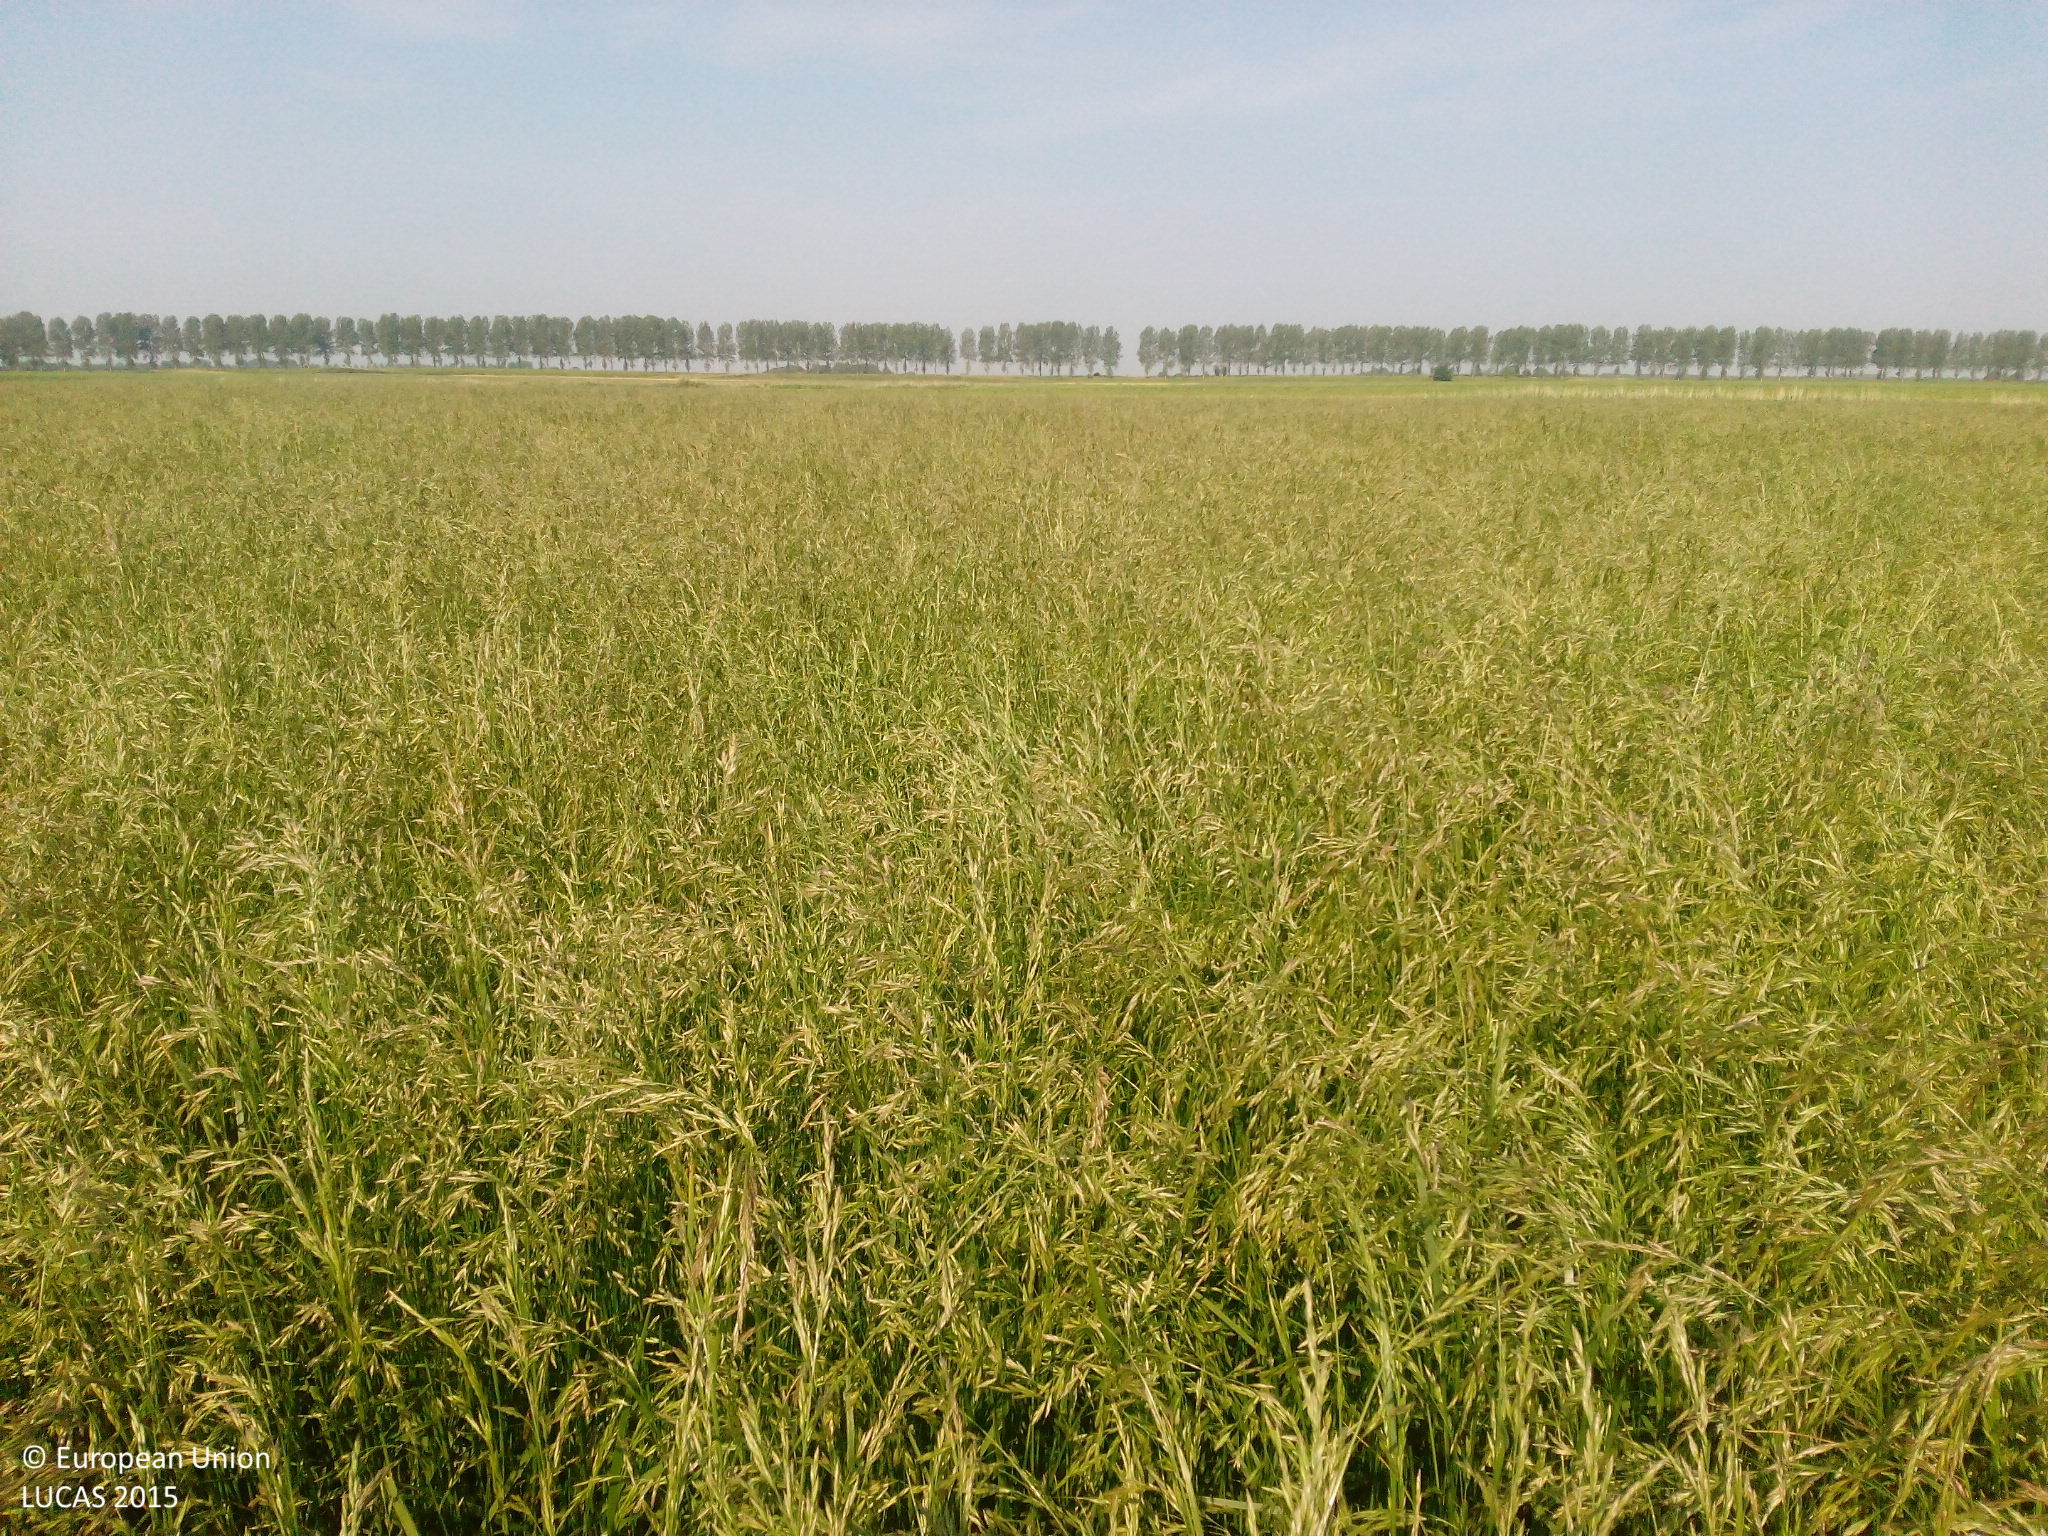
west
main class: Cropland
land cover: Temporary grasslands
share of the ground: > 75 %
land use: Agriculture (excluding fallow land and kitchen gardens)
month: June
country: NL
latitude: 51.5679
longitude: 4.1807
